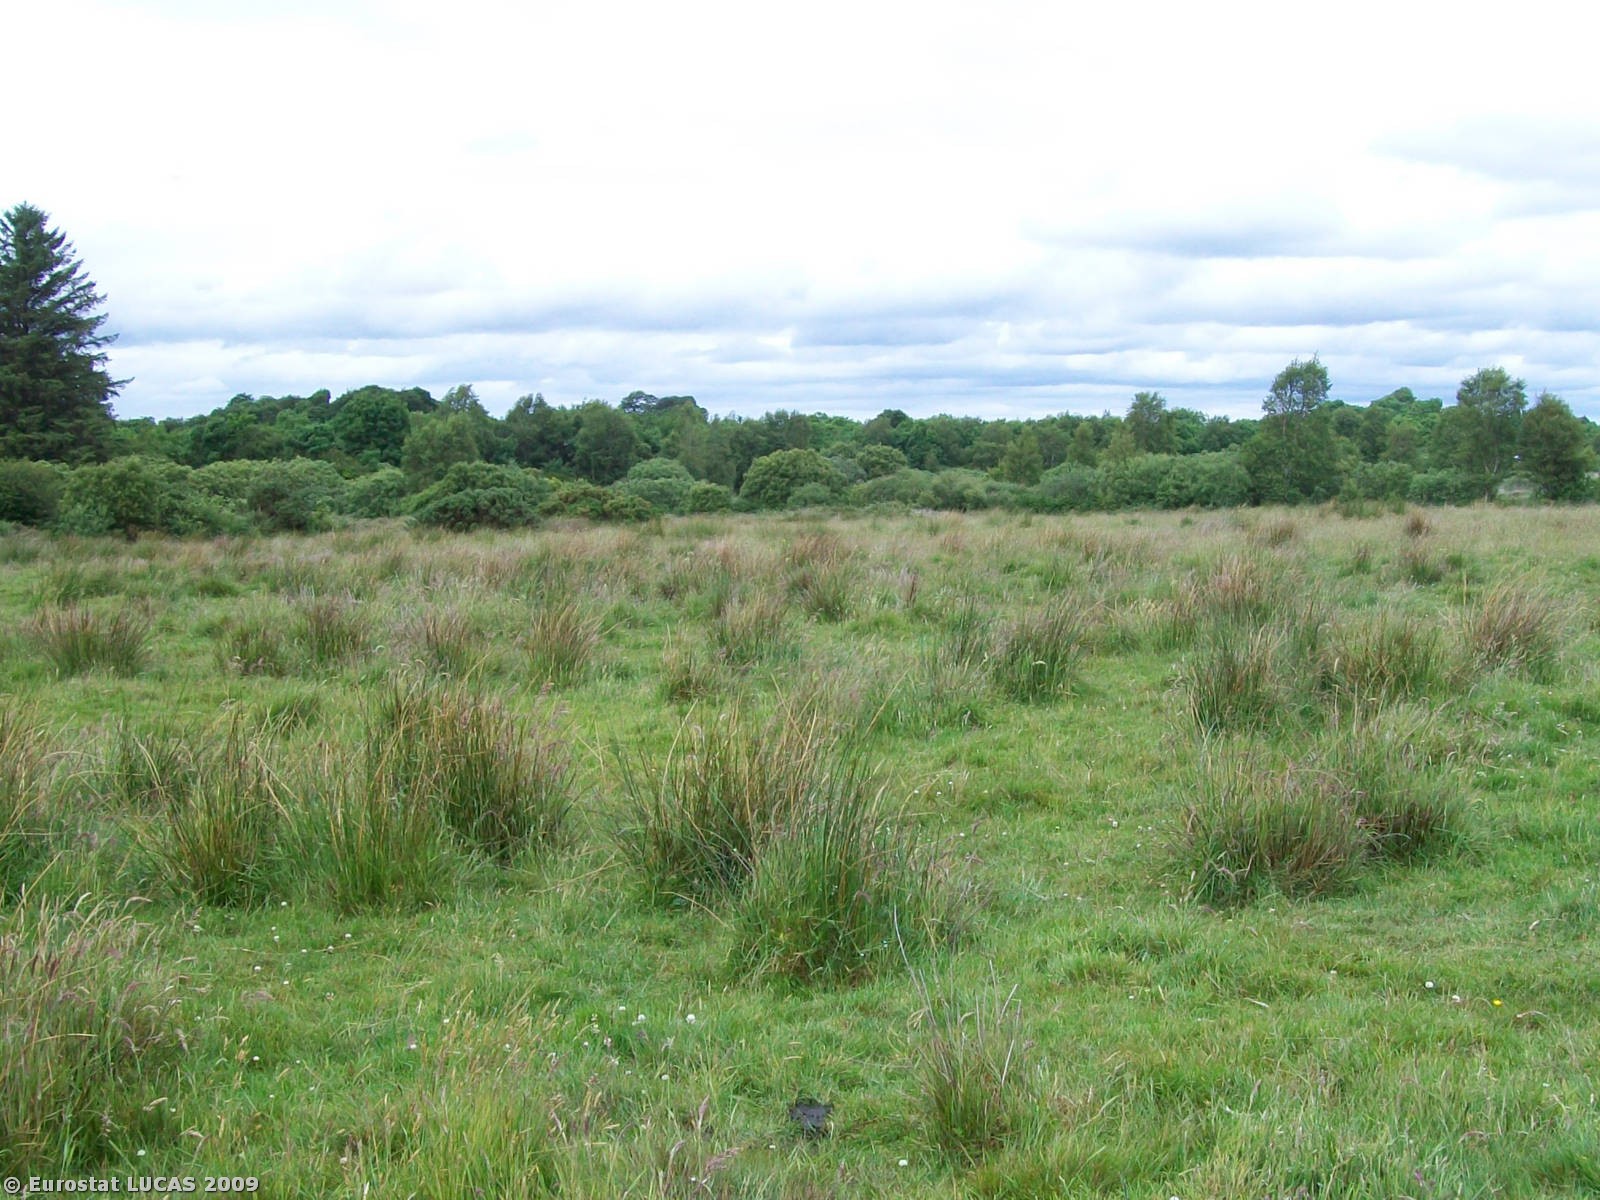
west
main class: Grassland
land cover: Grassland without tree/shrub cover
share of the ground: > 75 %
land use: Agriculture (excluding fallow land and kitchen gardens)
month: June
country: IE
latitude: 53.8153
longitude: -9.0316
